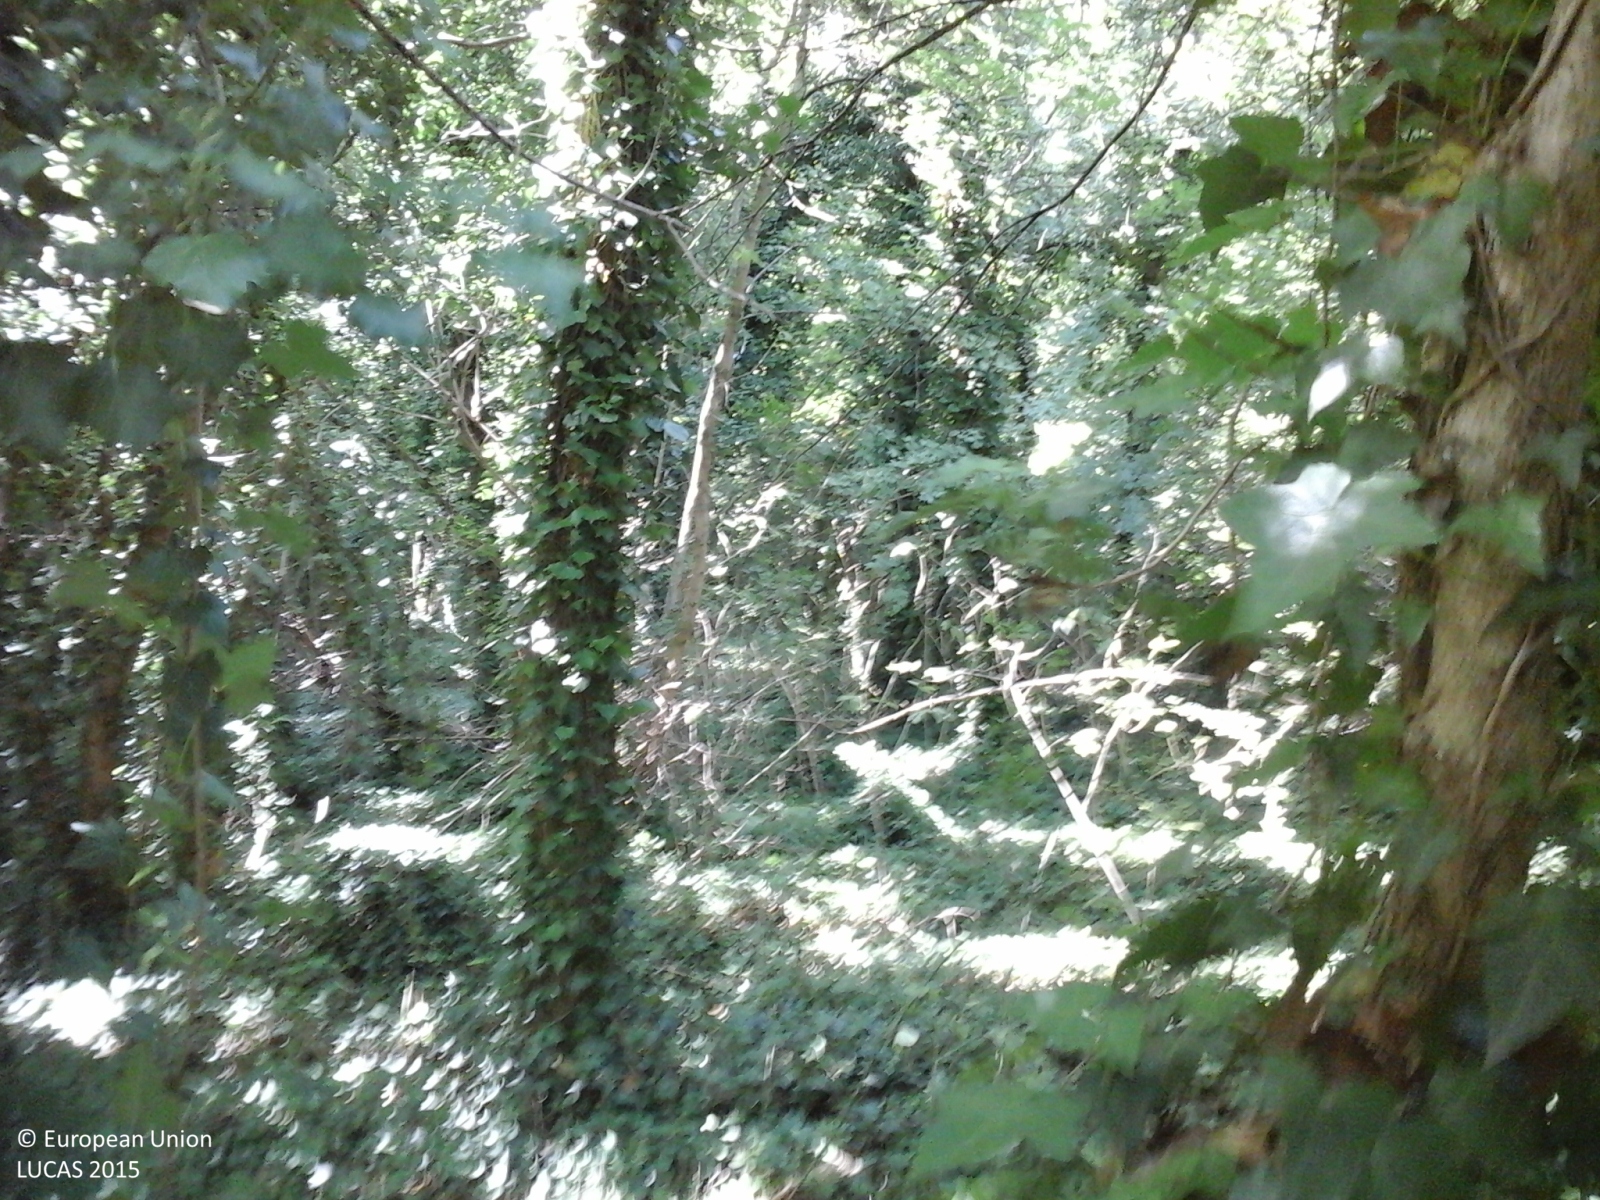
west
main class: Woodland
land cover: Broadleaved woodland
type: thermophilous deciduous forest
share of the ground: > 75 %
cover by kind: broadleaved forest trees 100 %
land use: Forestry
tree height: > 5 m
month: August
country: IT
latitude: 43.0654
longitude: 13.4413
